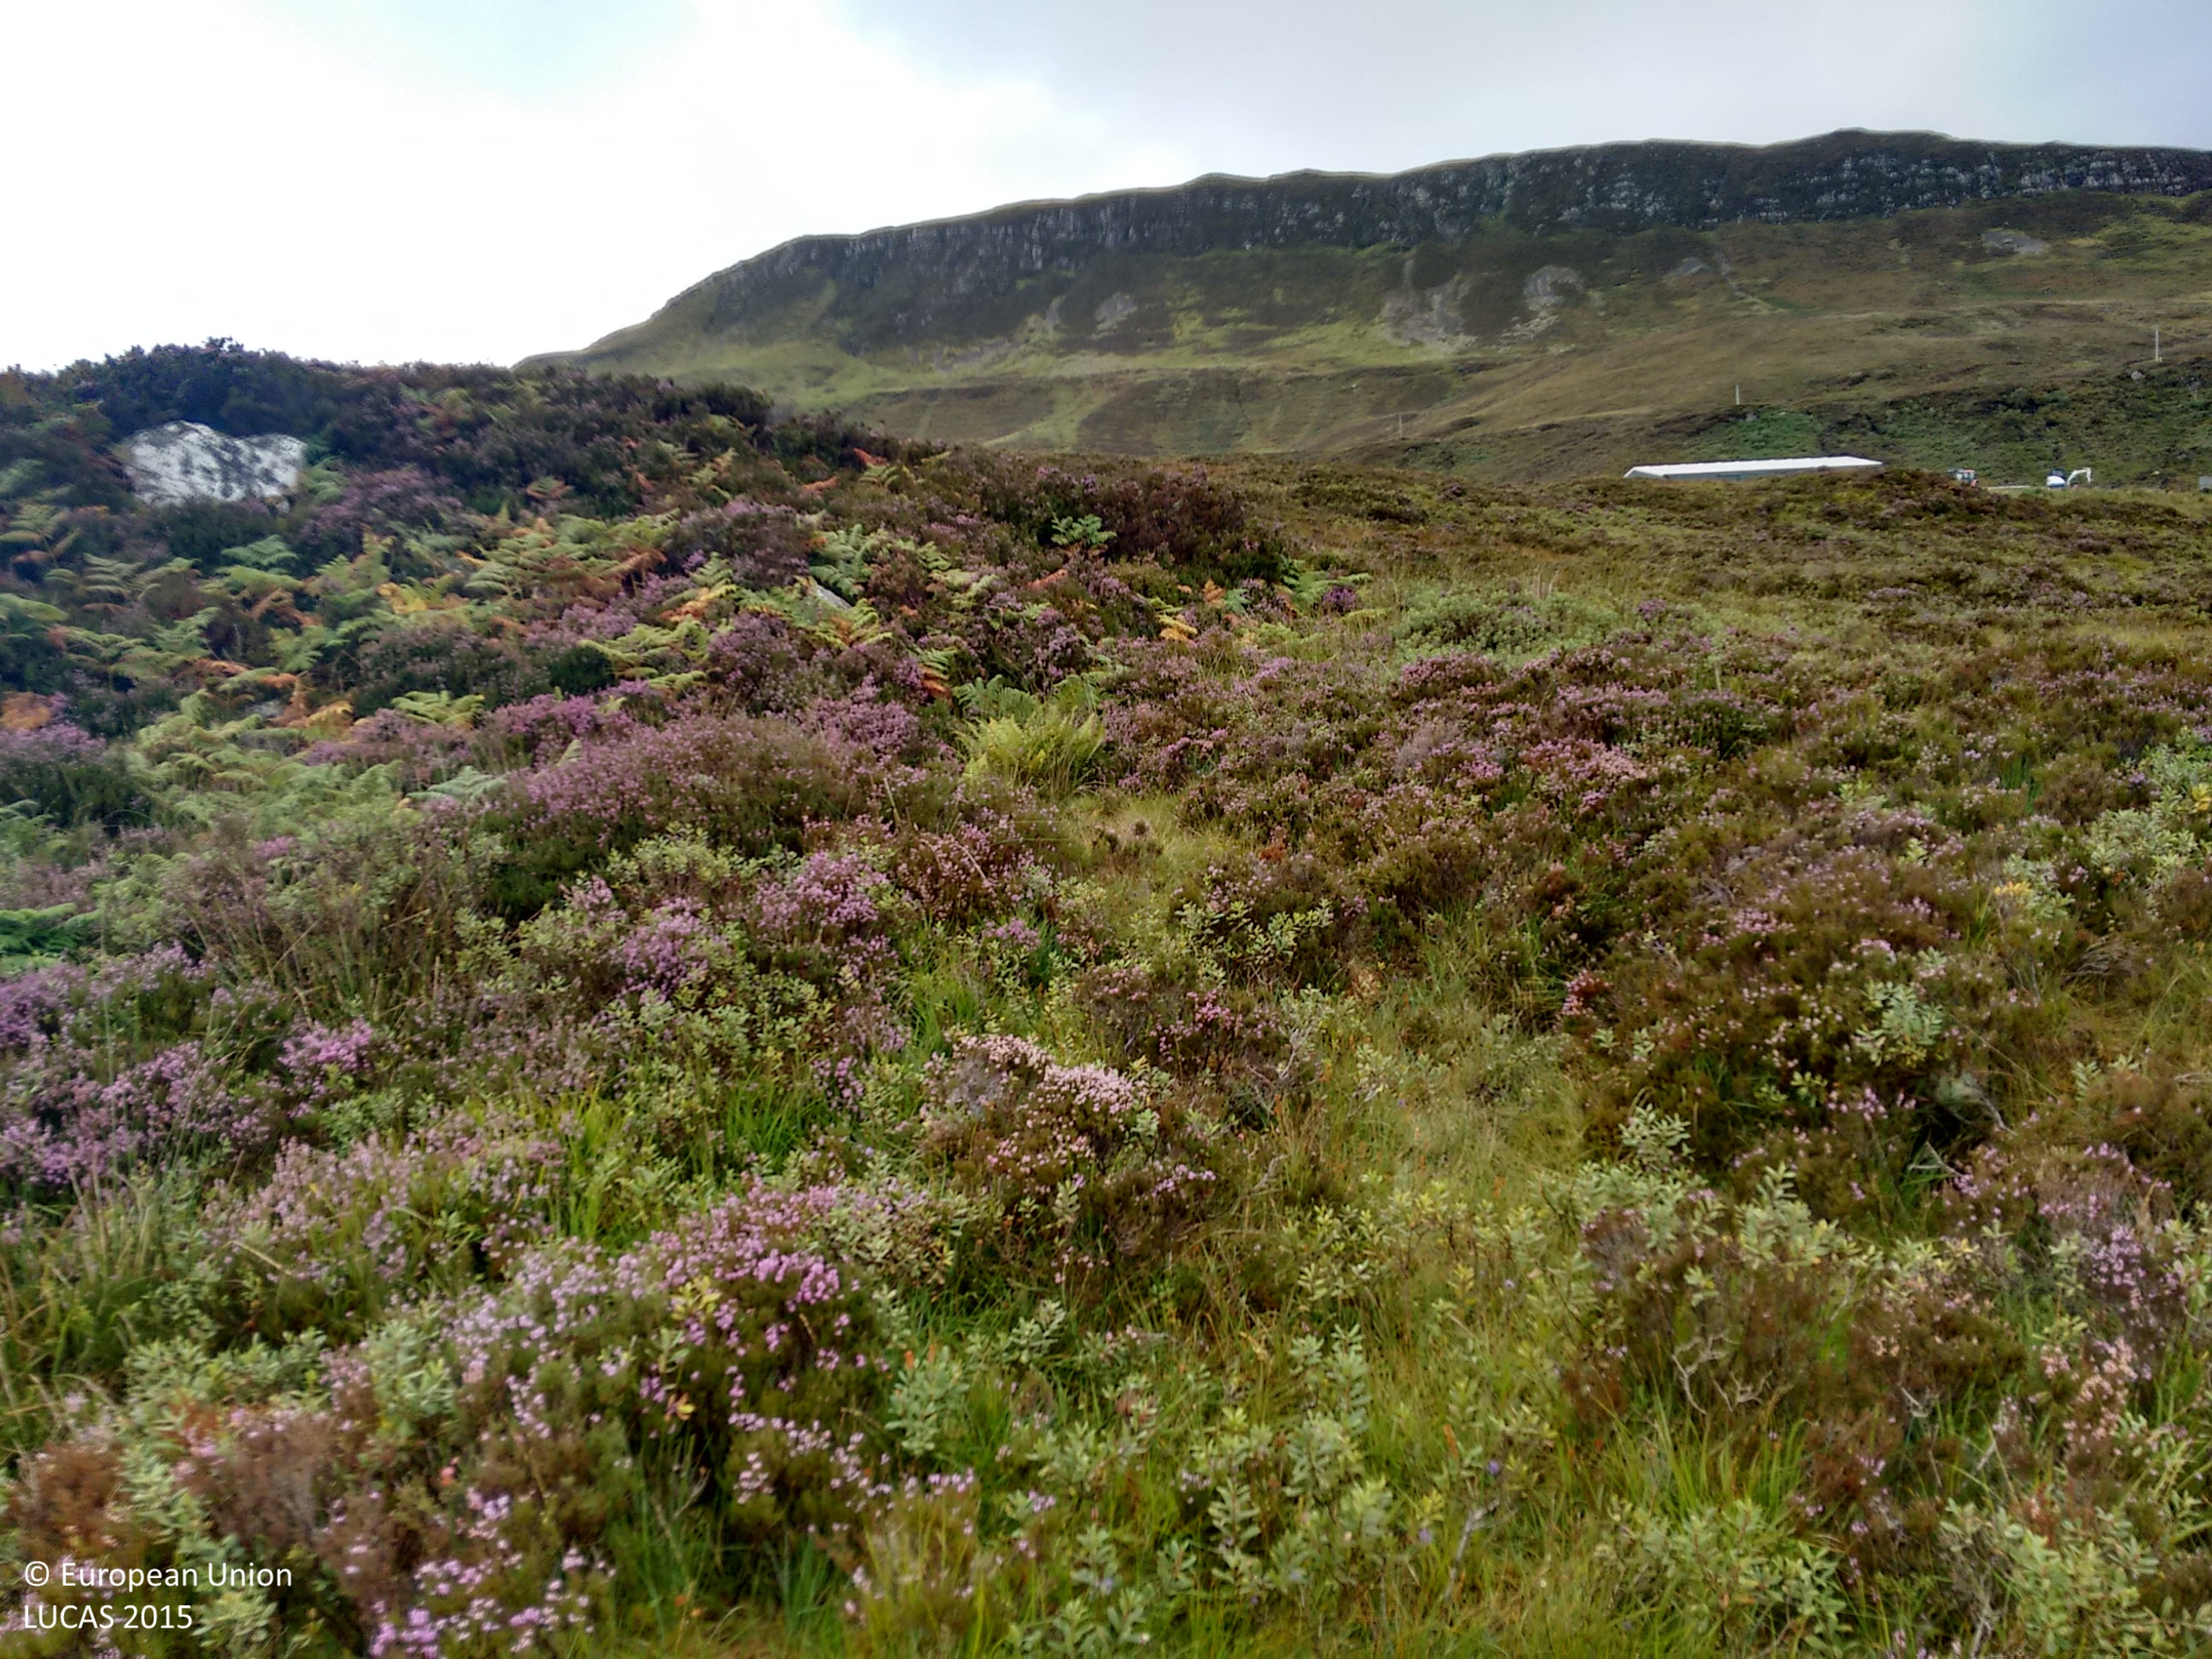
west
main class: Shrubland
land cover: Shrubland without tree cover
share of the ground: > 75 %
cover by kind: shrubs 100 %
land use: Semi-natural and natural areas not in use
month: September
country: GB
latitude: 57.1705
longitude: -6.0583
